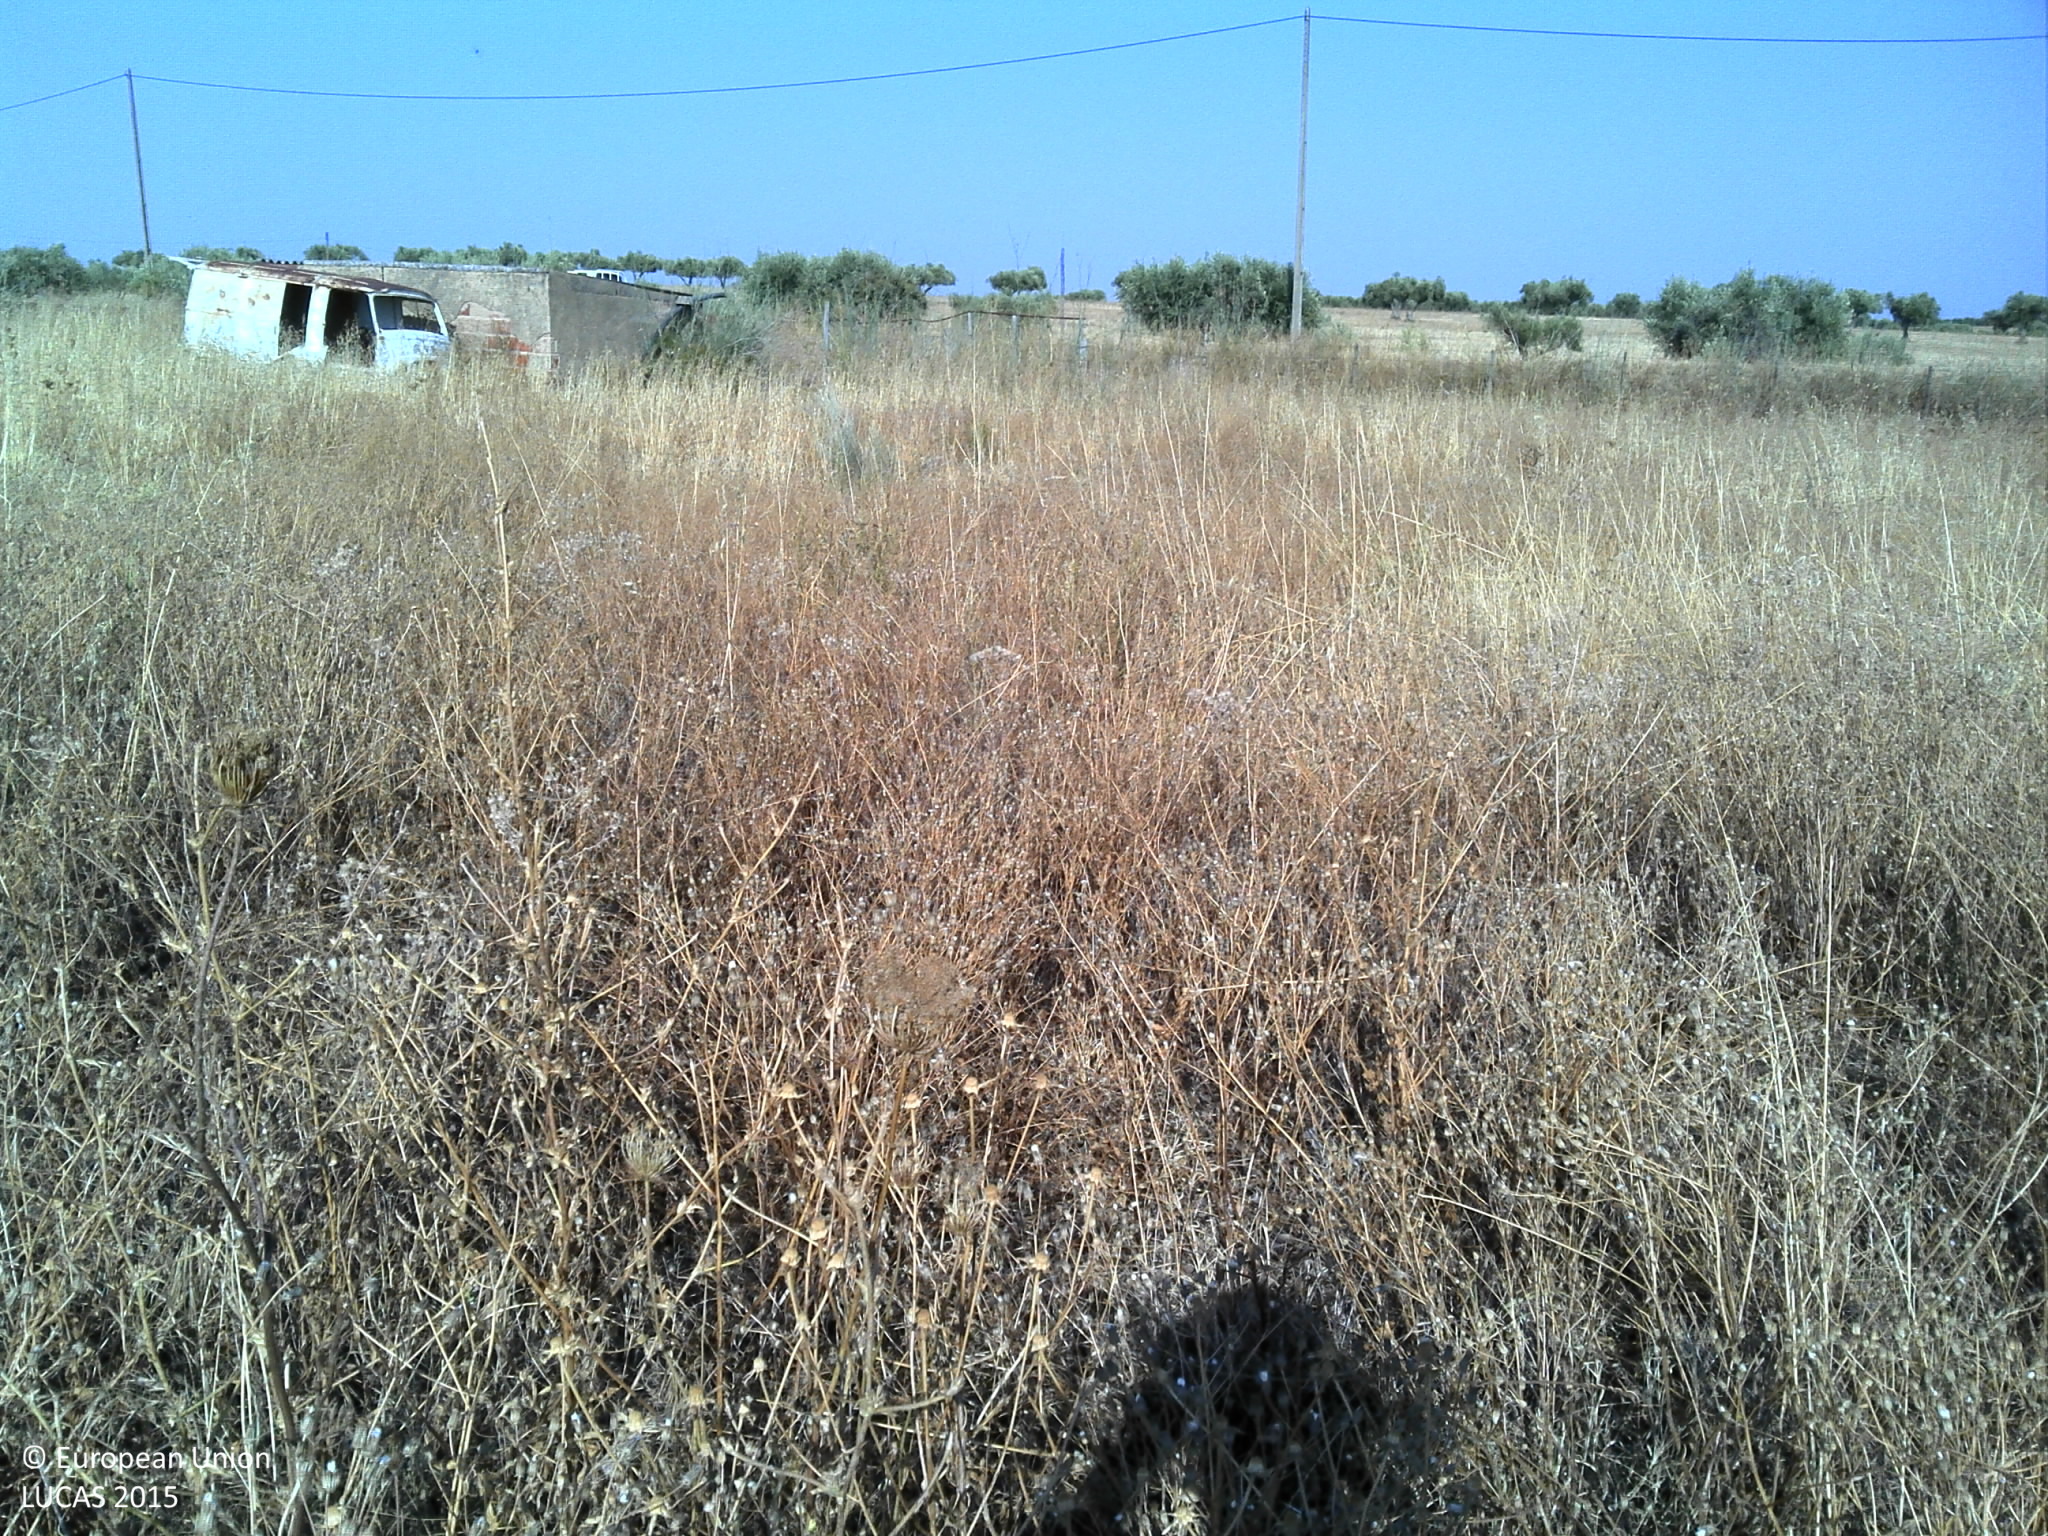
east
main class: Grassland
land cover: Grassland without tree/shrub cover
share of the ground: > 75 %
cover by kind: herbaceous plants 100 %
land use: Agriculture (excluding fallow land and kitchen gardens)
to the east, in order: Grassland without tree/shrub cover; Fences; Grass margins; Paved roads, cycling and walking lanes; Grass margins; Electric lines; Grass margins; Fences; Other structural elements; Olive groves; Electric lines; Olive groves; Grassland without tree/shrub cover; Olive groves; Grassland without tree/shrub cover
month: June
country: PT
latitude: 38.2810
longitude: -7.3634
